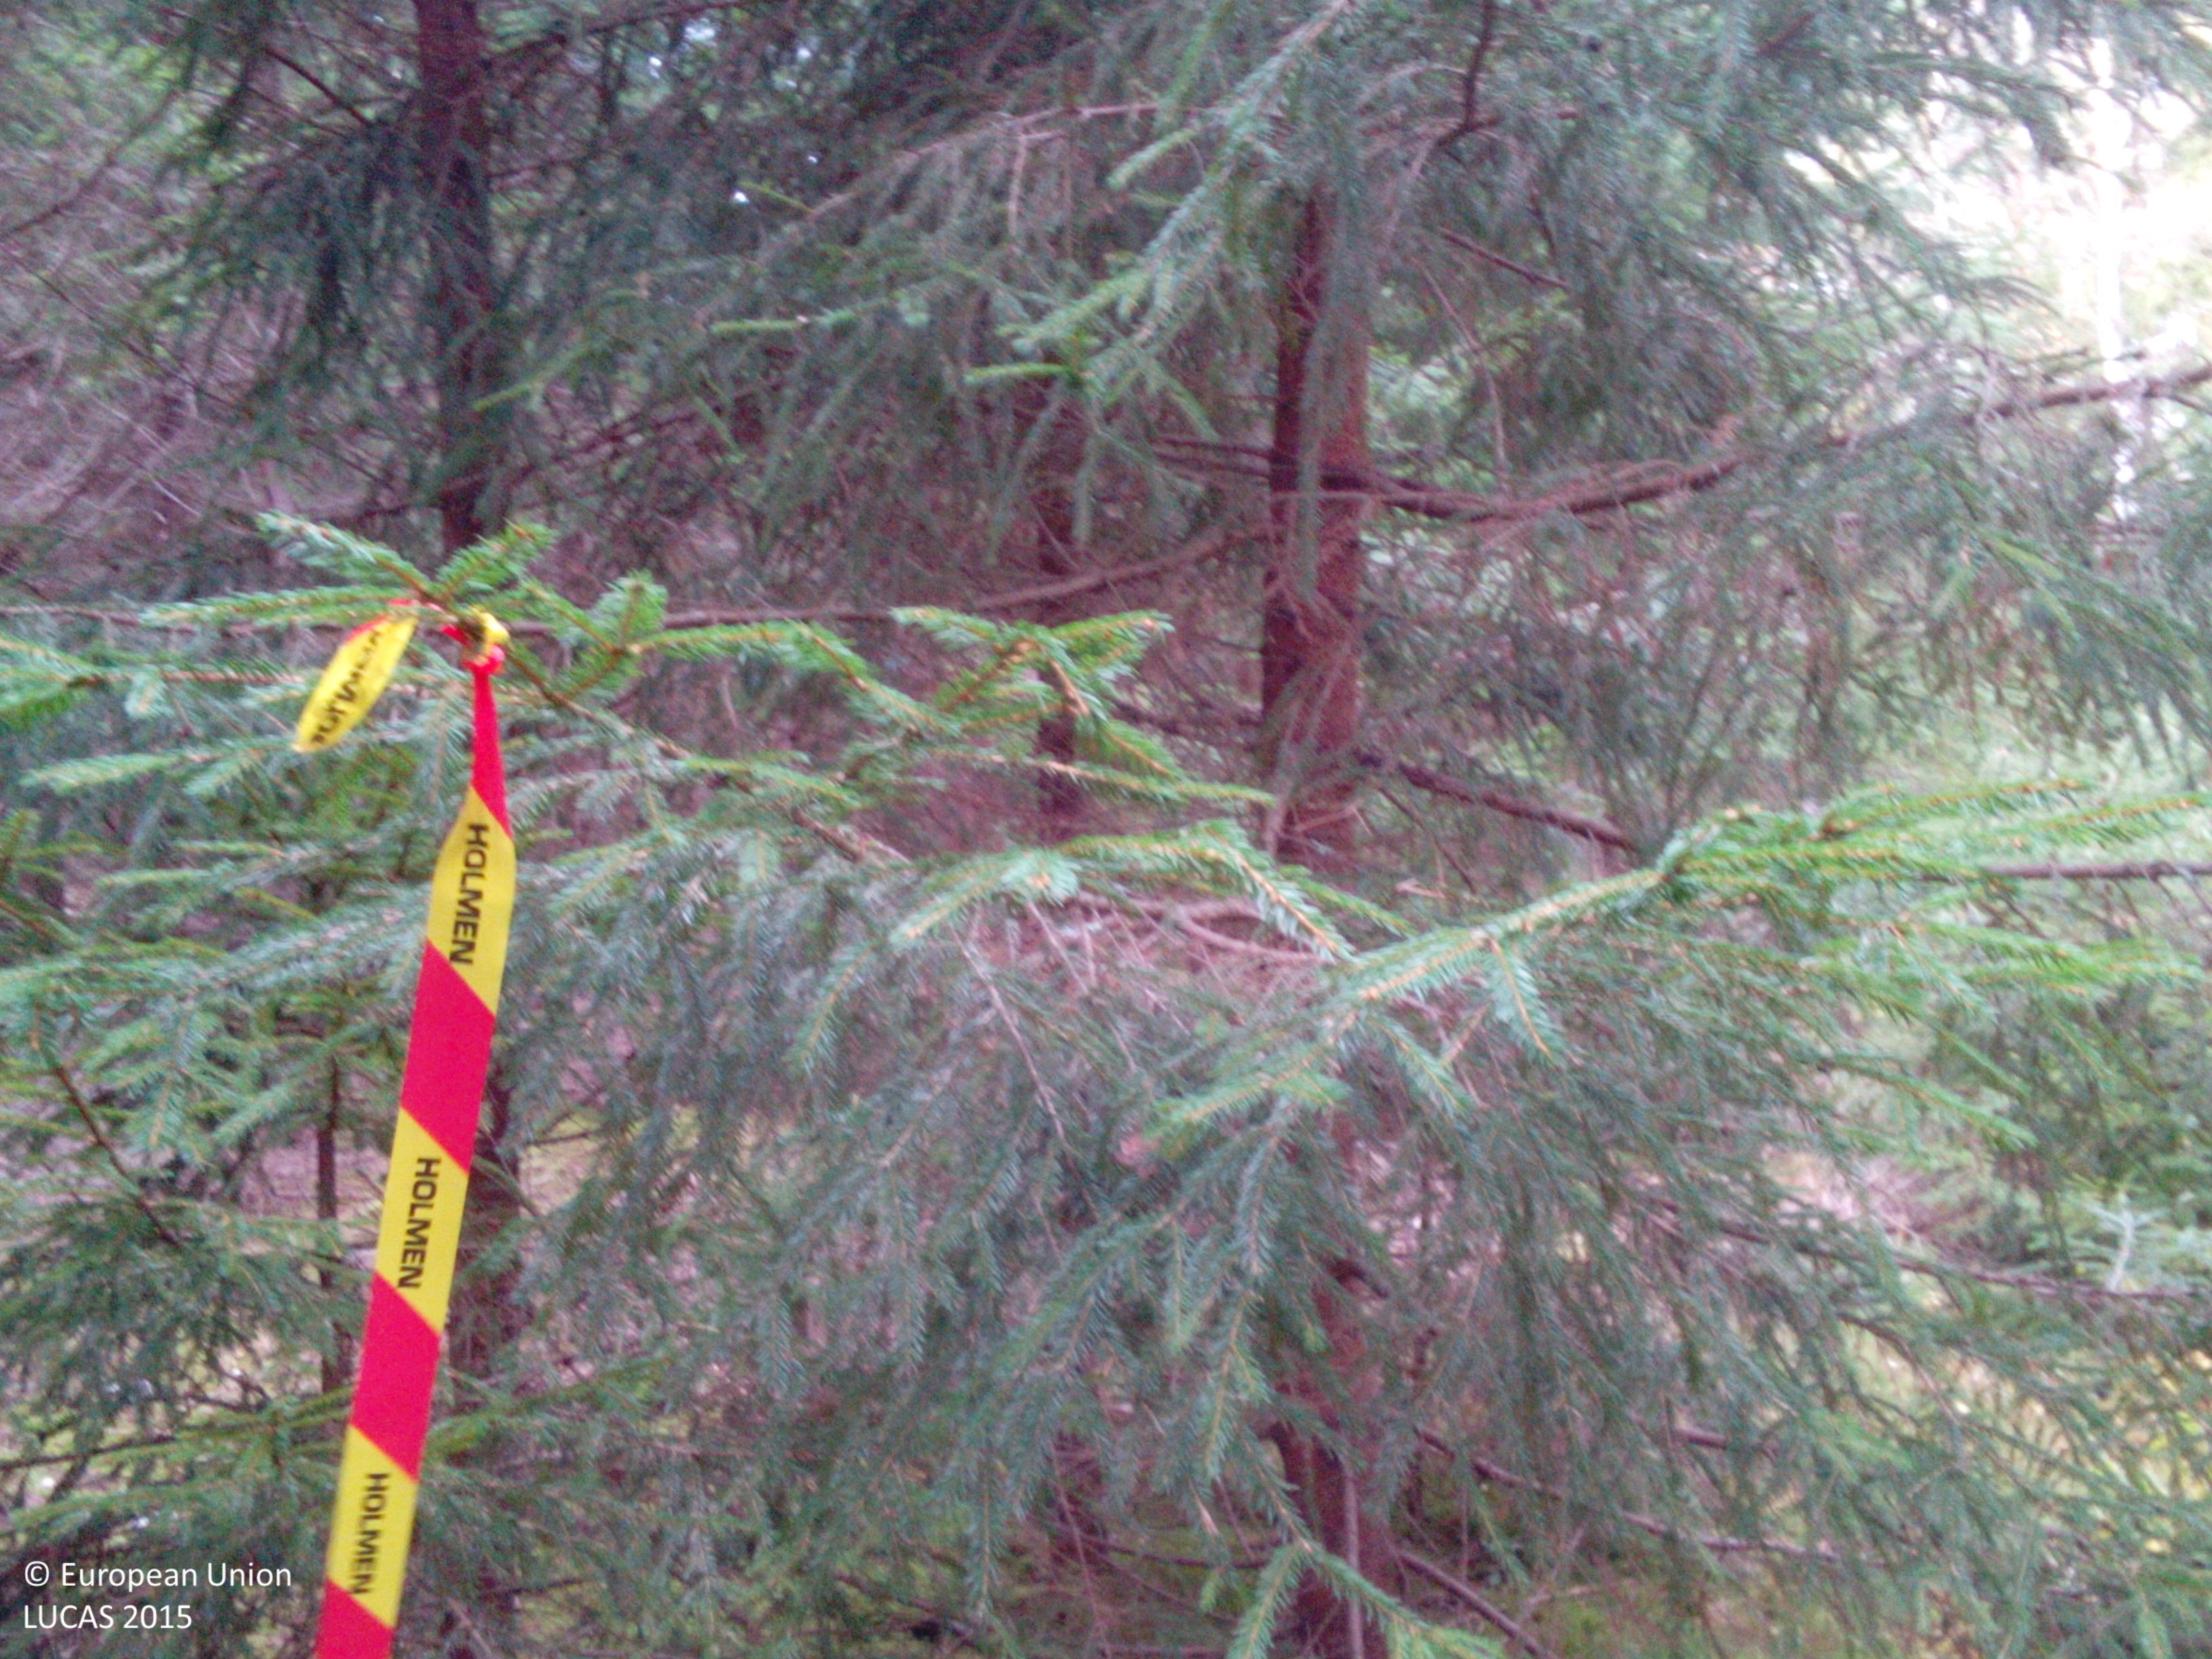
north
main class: Woodland
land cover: Spruce dominated coniferous woodland
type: boreal forest
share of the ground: 50 - 75 %
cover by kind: coniferous forest trees 75 %, lichens and mosses 15 %, herbaceous plants 10 %
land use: Forestry
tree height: > 5 m
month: October
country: SE
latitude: 59.2442
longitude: 16.3221
